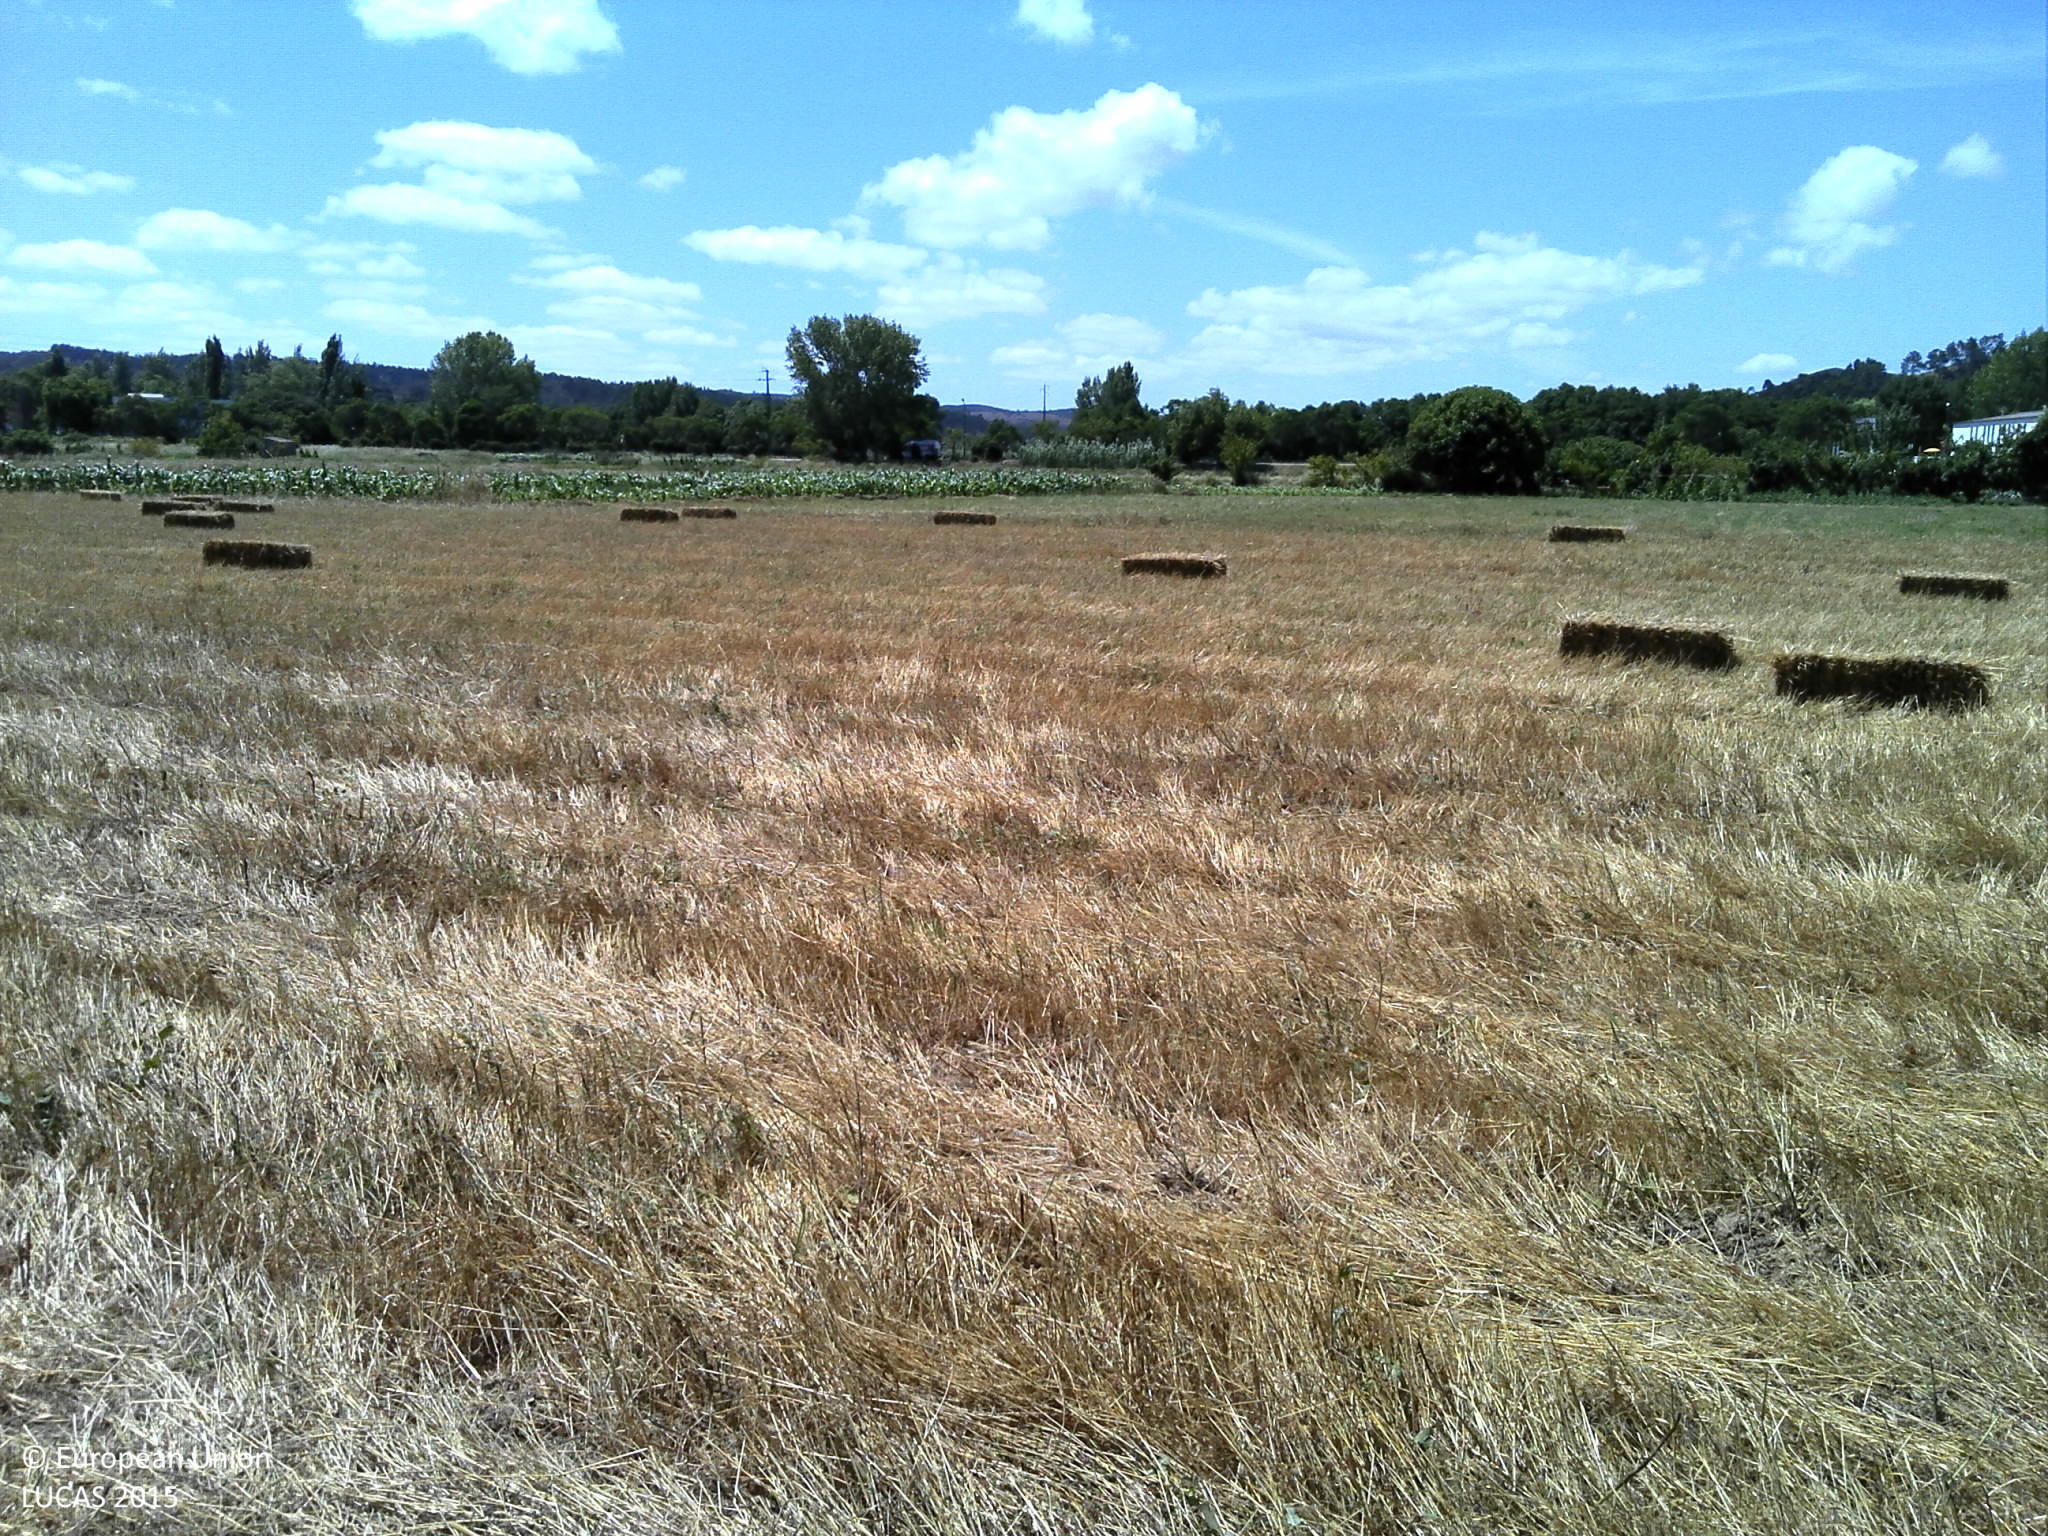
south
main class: Cropland
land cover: Durum wheat
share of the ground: 25 - 50 %
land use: Agriculture (excluding fallow land and kitchen gardens)
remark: Harvested field
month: June
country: PT
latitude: 37.3191
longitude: -8.8020
